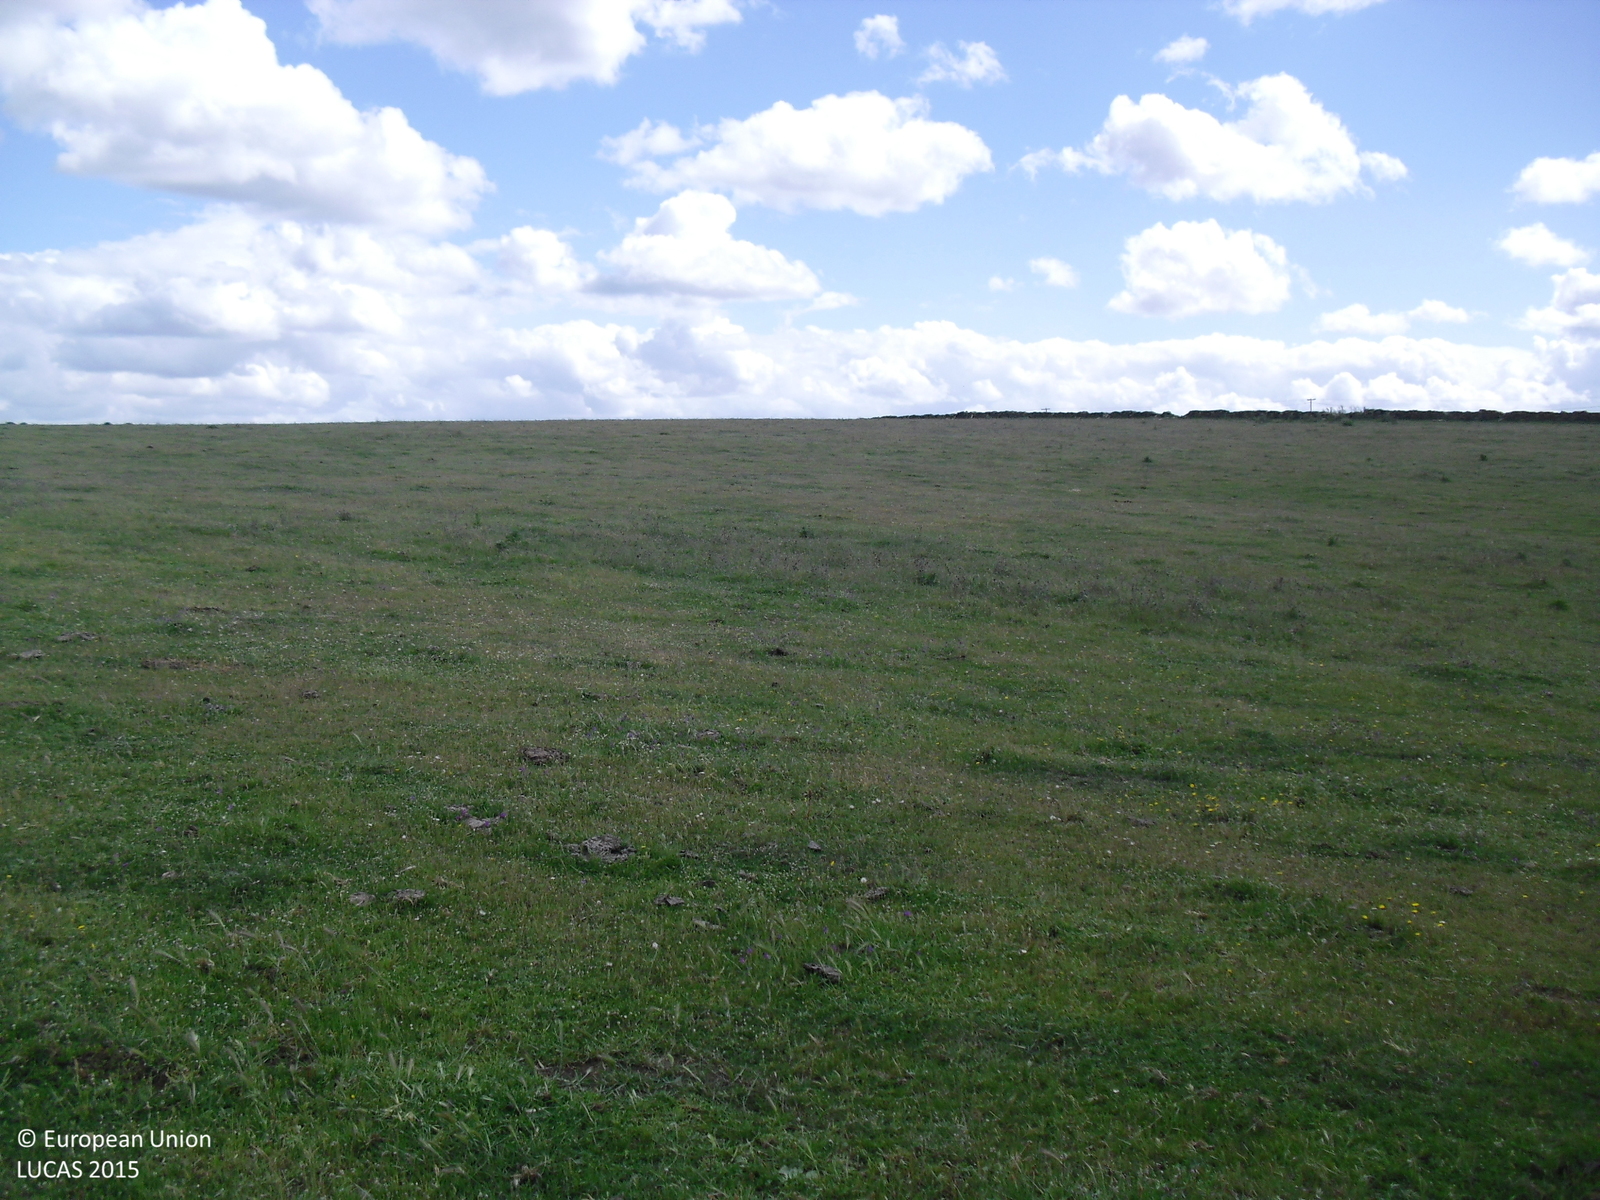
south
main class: Grassland
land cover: Grassland without tree/shrub cover
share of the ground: > 75 %
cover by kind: herbaceous plants 100 %
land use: Agriculture (excluding fallow land and kitchen gardens)
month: April
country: ES
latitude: 39.3920
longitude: -7.1395
